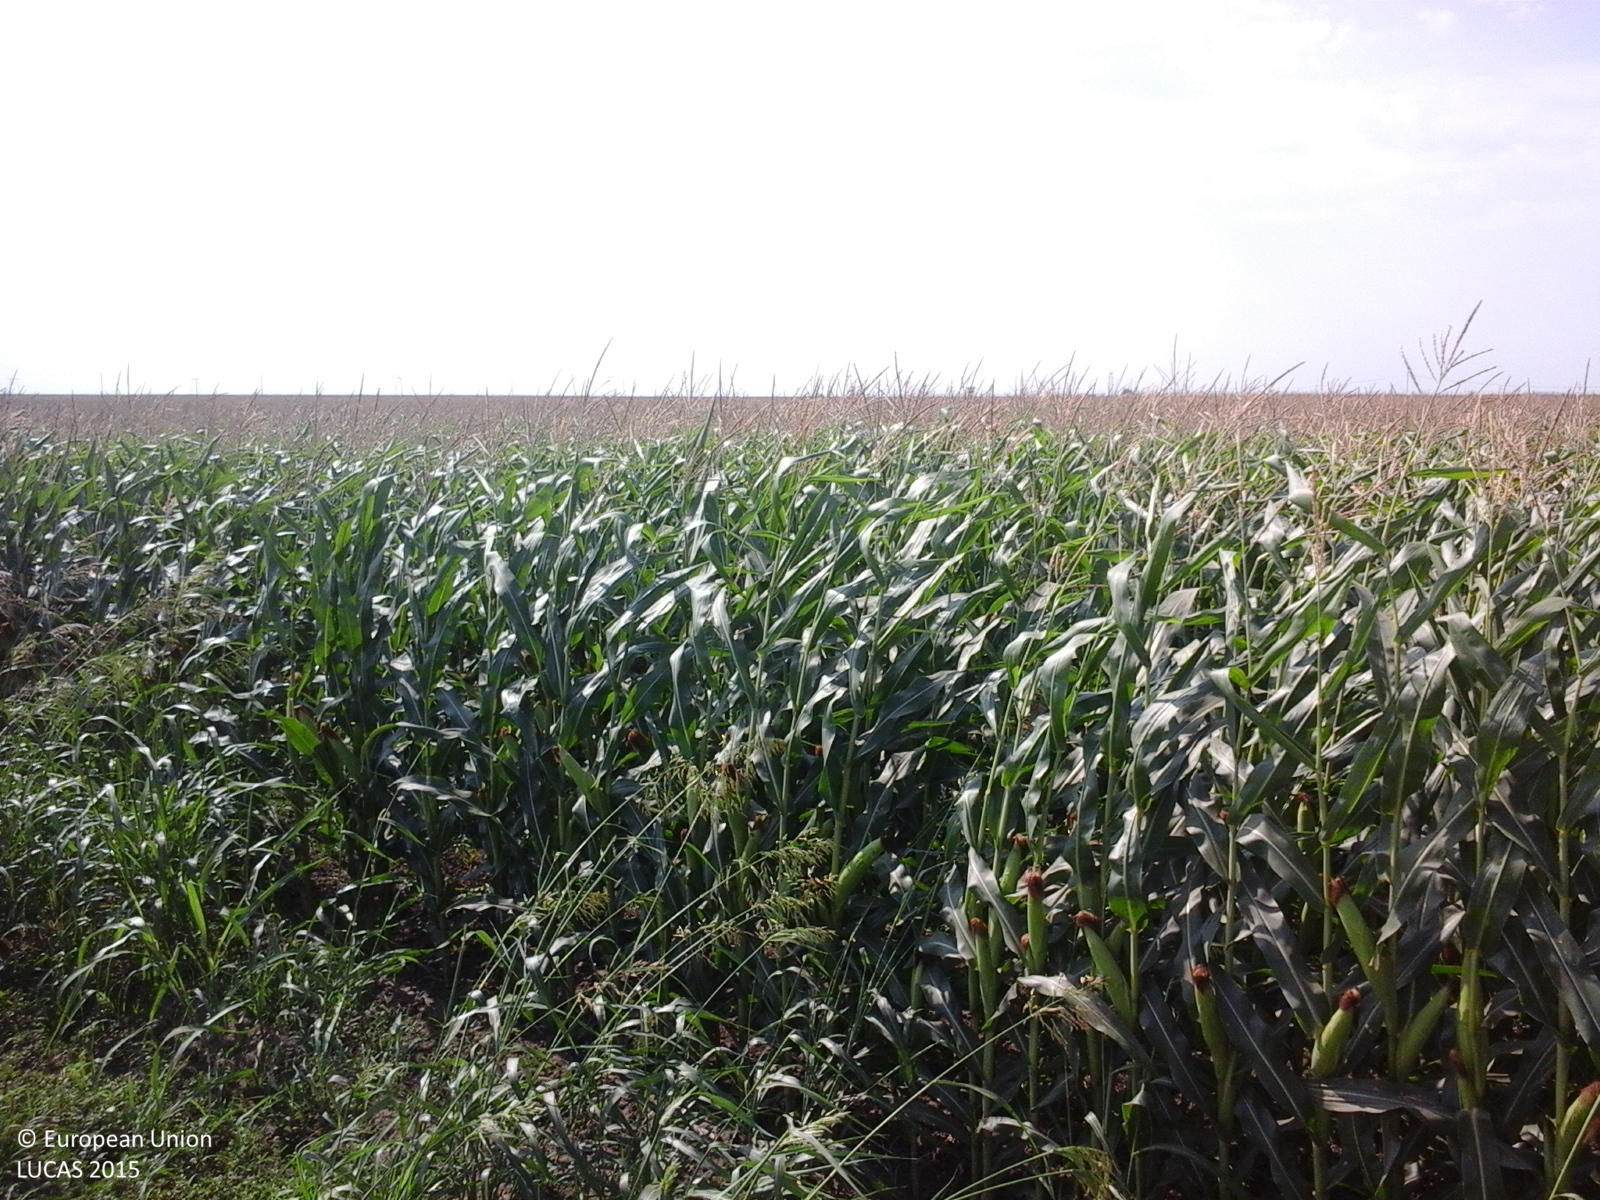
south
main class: Cropland
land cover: Maize
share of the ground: > 75 %
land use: Agriculture (excluding fallow land and kitchen gardens)
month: July
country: RO
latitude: 44.6464
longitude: 27.2212
